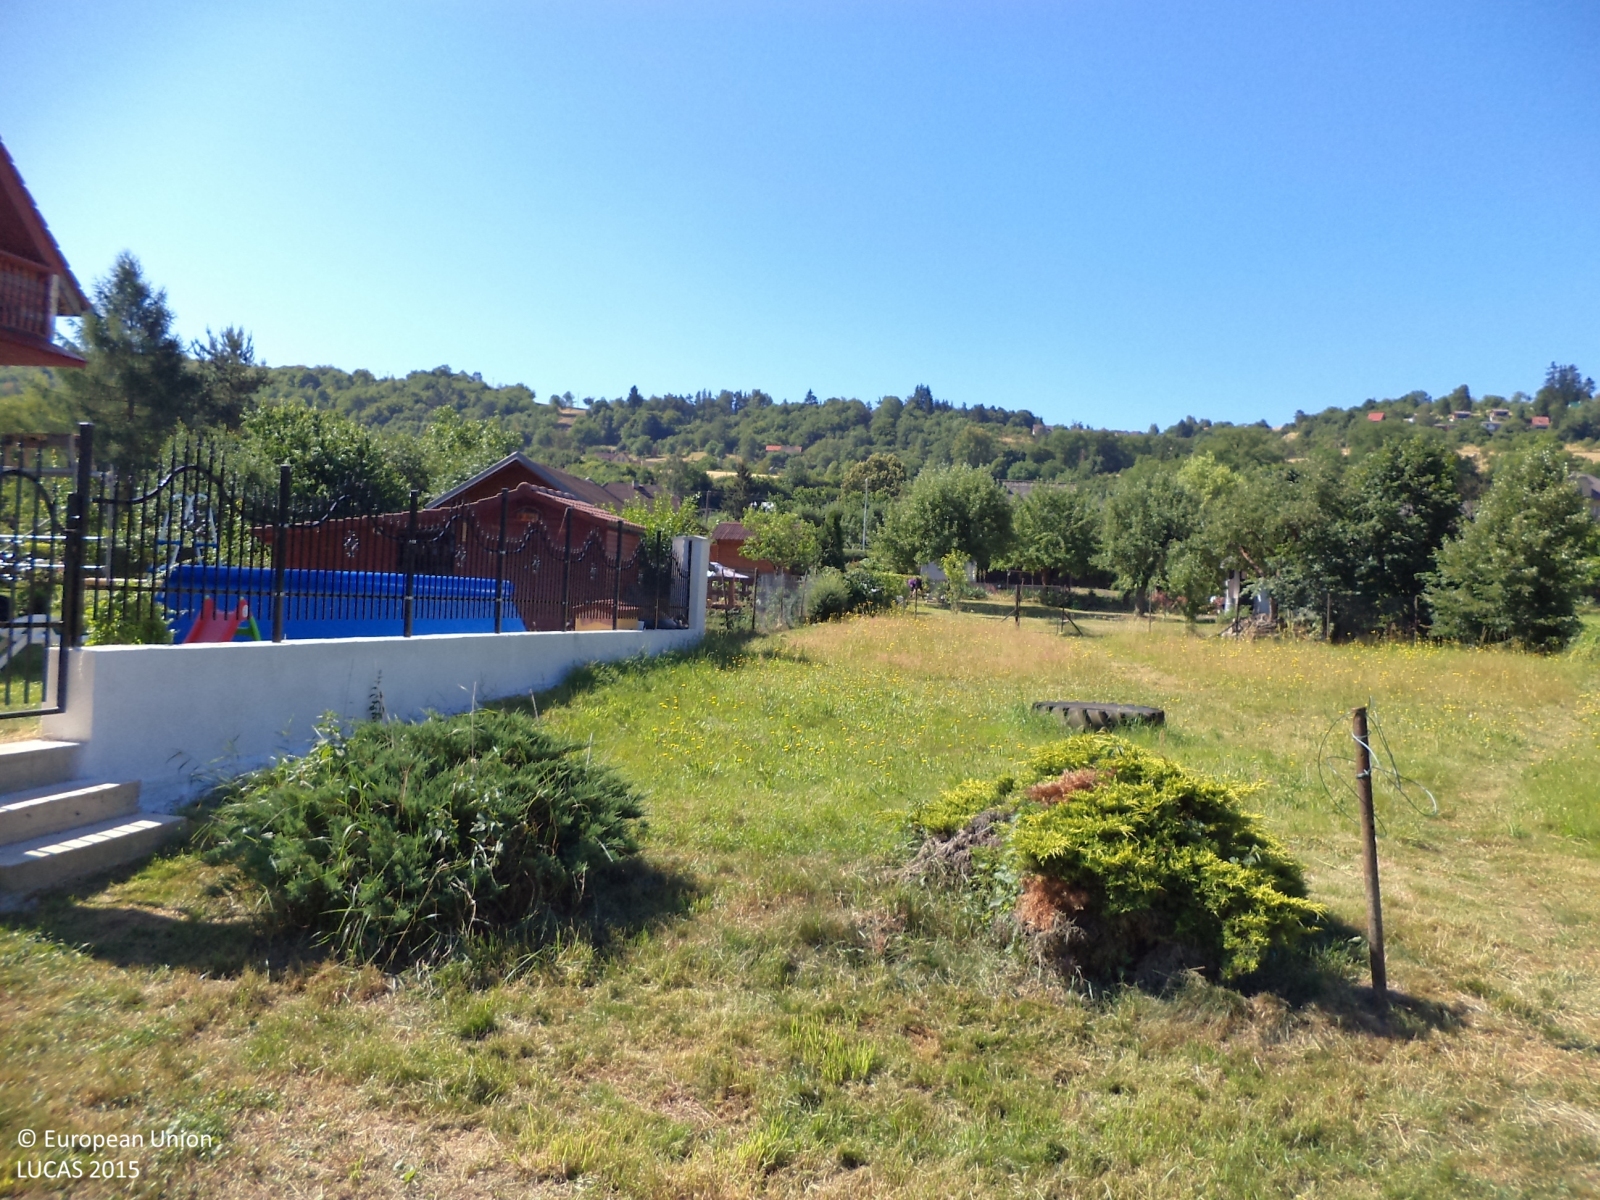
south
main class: Grassland
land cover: Grassland without tree/shrub cover
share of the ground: > 75 %
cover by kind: herbaceous plants 100 %
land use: Agriculture (excluding fallow land and kitchen gardens)
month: July
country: CZ
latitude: 50.0268
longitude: 13.9232
